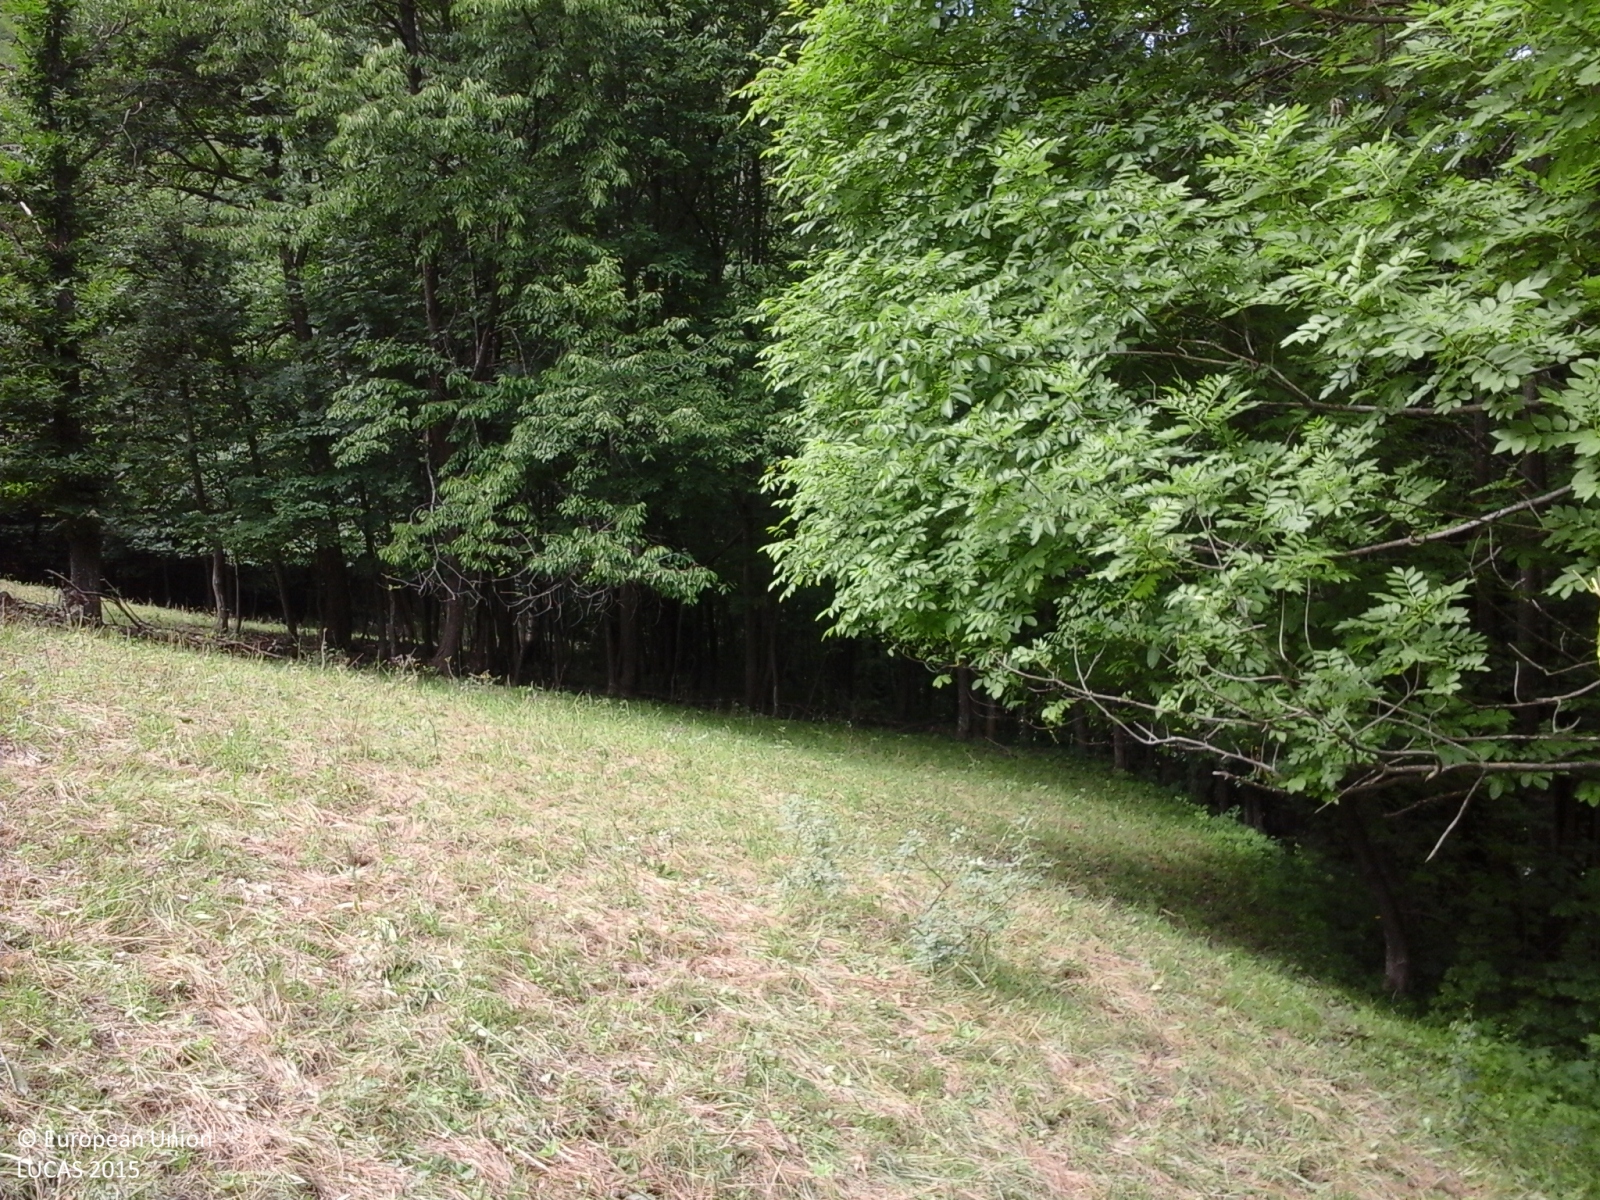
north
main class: Grassland
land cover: Grassland without tree/shrub cover
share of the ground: > 75 %
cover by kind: herbaceous plants 100 %
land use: Agriculture (excluding fallow land and kitchen gardens)
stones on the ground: < 10 %
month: June
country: IT
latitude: 44.2379
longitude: 7.8387
